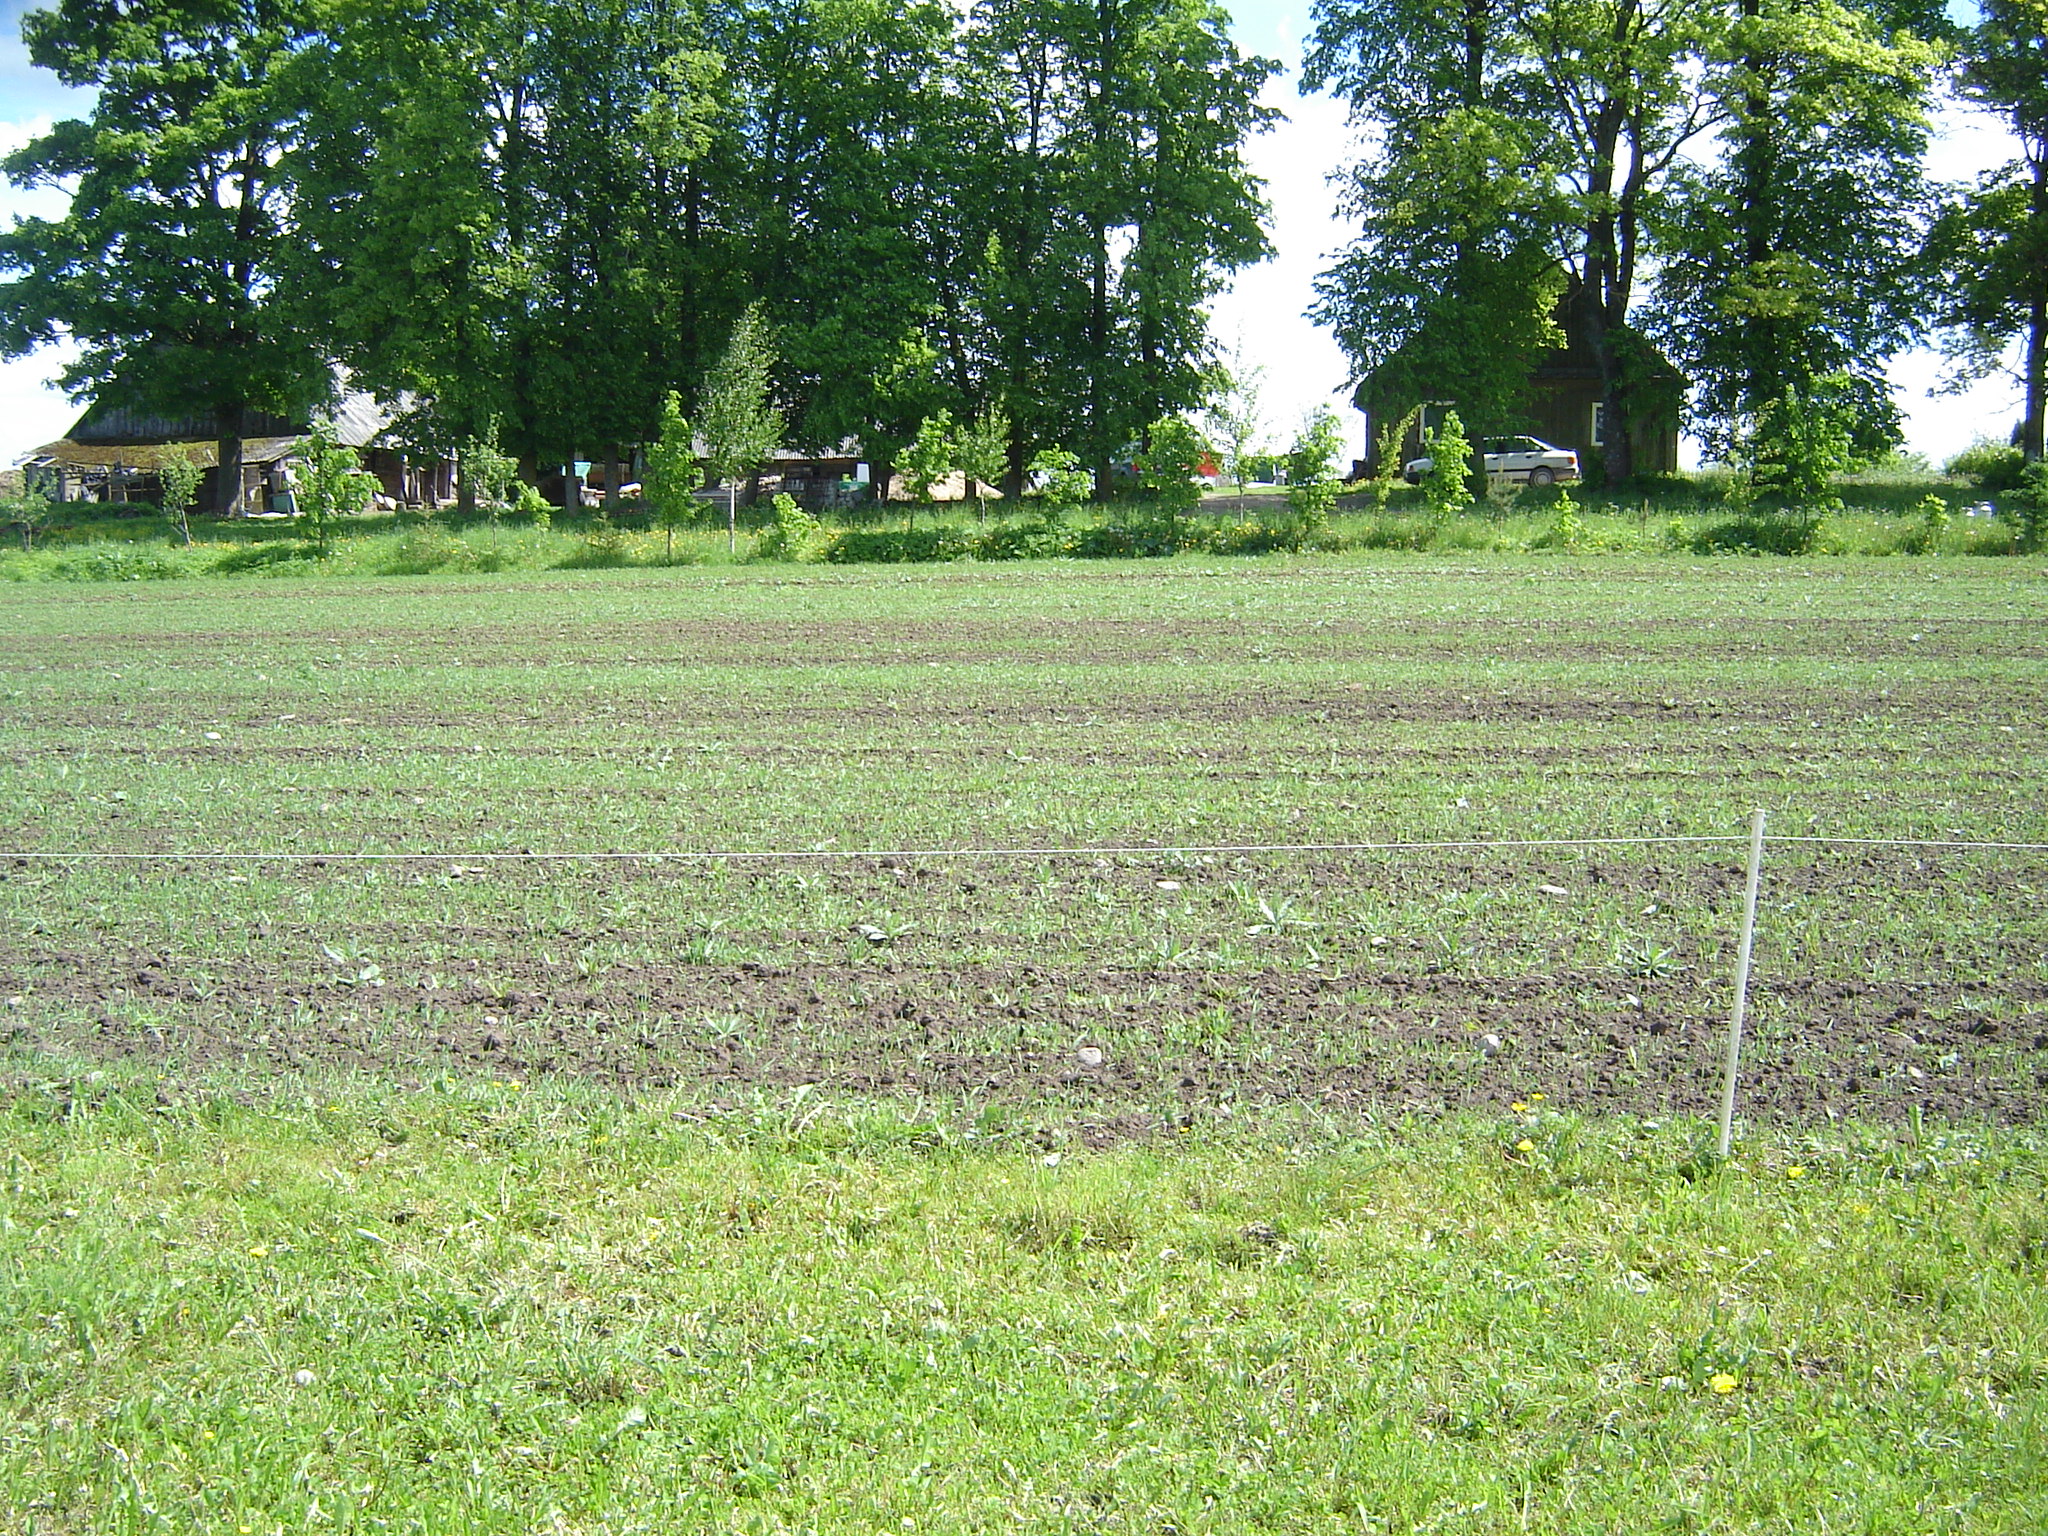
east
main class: Grassland
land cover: Grassland without tree/shrub cover
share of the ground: > 75 %
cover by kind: herbaceous plants 100 %
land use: Agriculture (excluding fallow land and kitchen gardens)
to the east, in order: Grassland without tree/shrub cover; Fences; Common wheat; Managed hedges; Grassland without tree/shrub cover; Artificial constructions in urban areas; Inland fresh water bodies; Grass margins; Potatoes; Grassland without tree/shrub cover; Barley
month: May
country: LT
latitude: 55.8070
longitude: 25.1931
